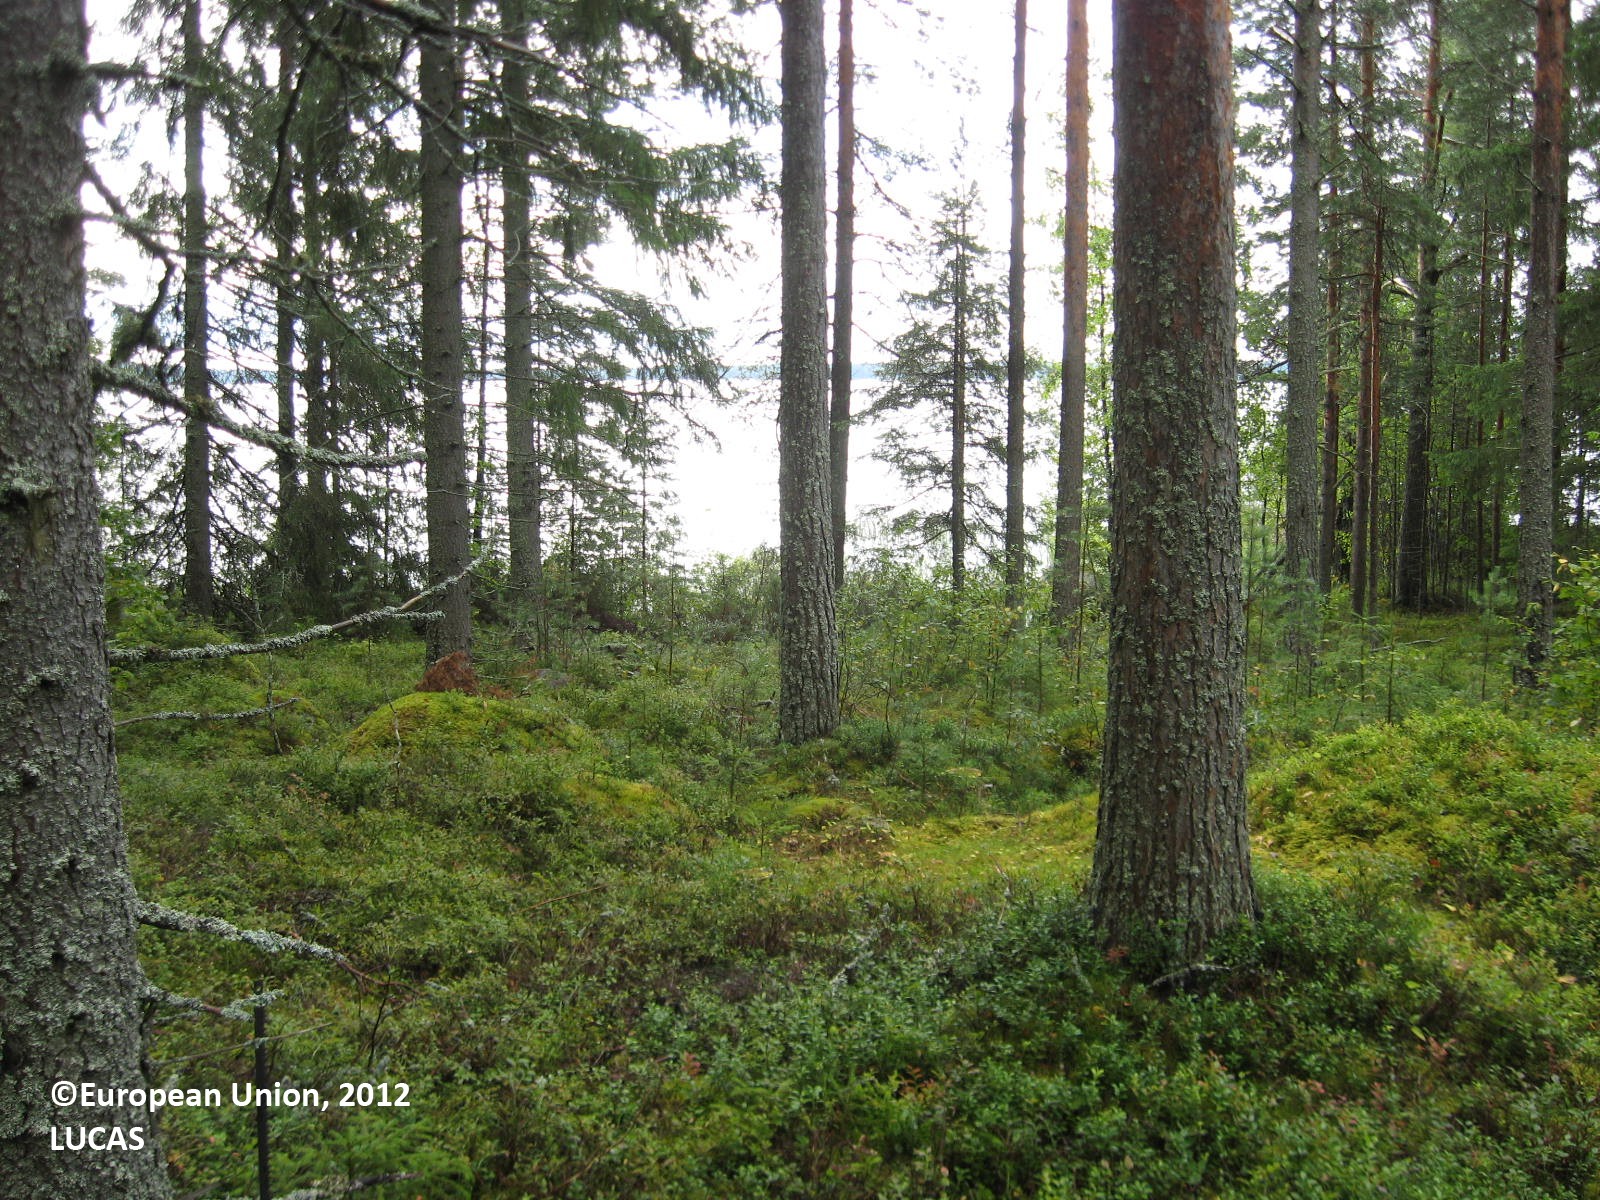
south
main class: Woodland
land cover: Other mixed woodland
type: boreal forest
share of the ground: > 75 %
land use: Forestry
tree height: > 5 m
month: August
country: FI
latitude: 63.3968
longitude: 29.7542
